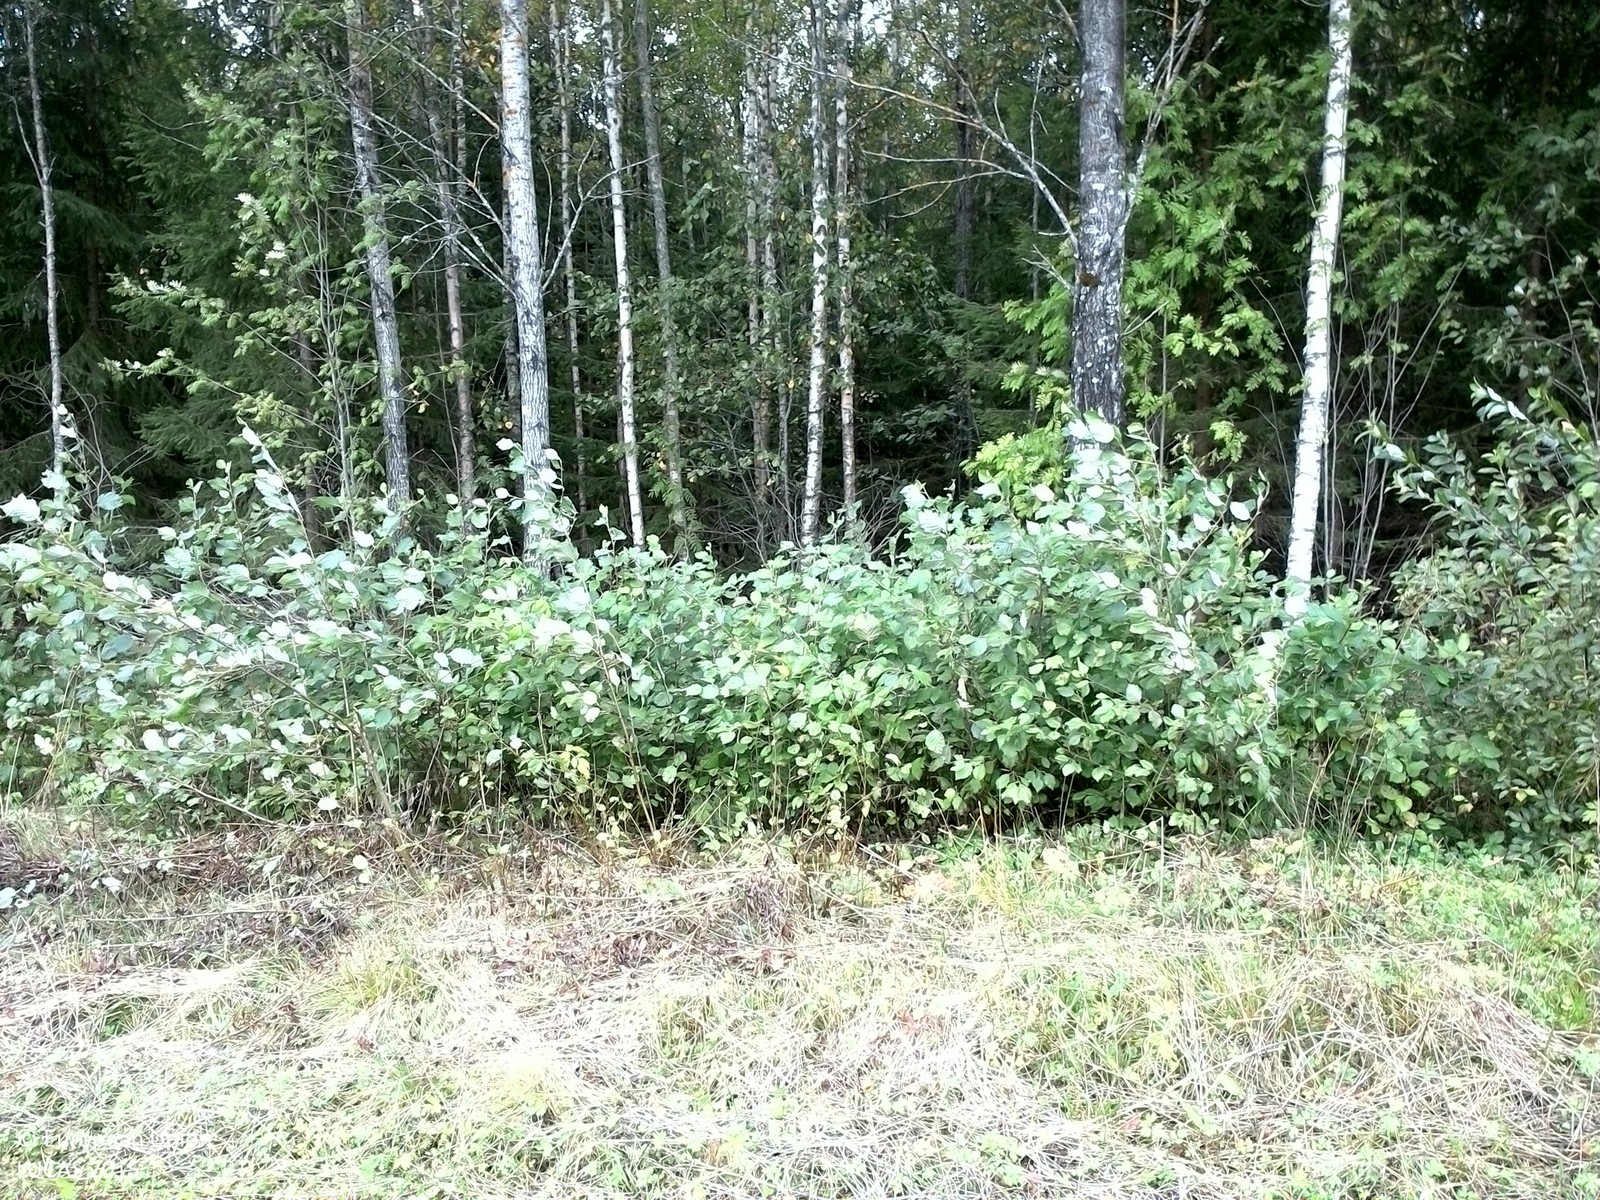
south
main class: Grassland
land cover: Grassland without tree/shrub cover
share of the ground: > 75 %
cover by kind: herbaceous plants 90 %, consolidated bare surface 10 %
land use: Agriculture (excluding fallow land and kitchen gardens)
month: September
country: SE
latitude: 59.8317
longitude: 13.4700
